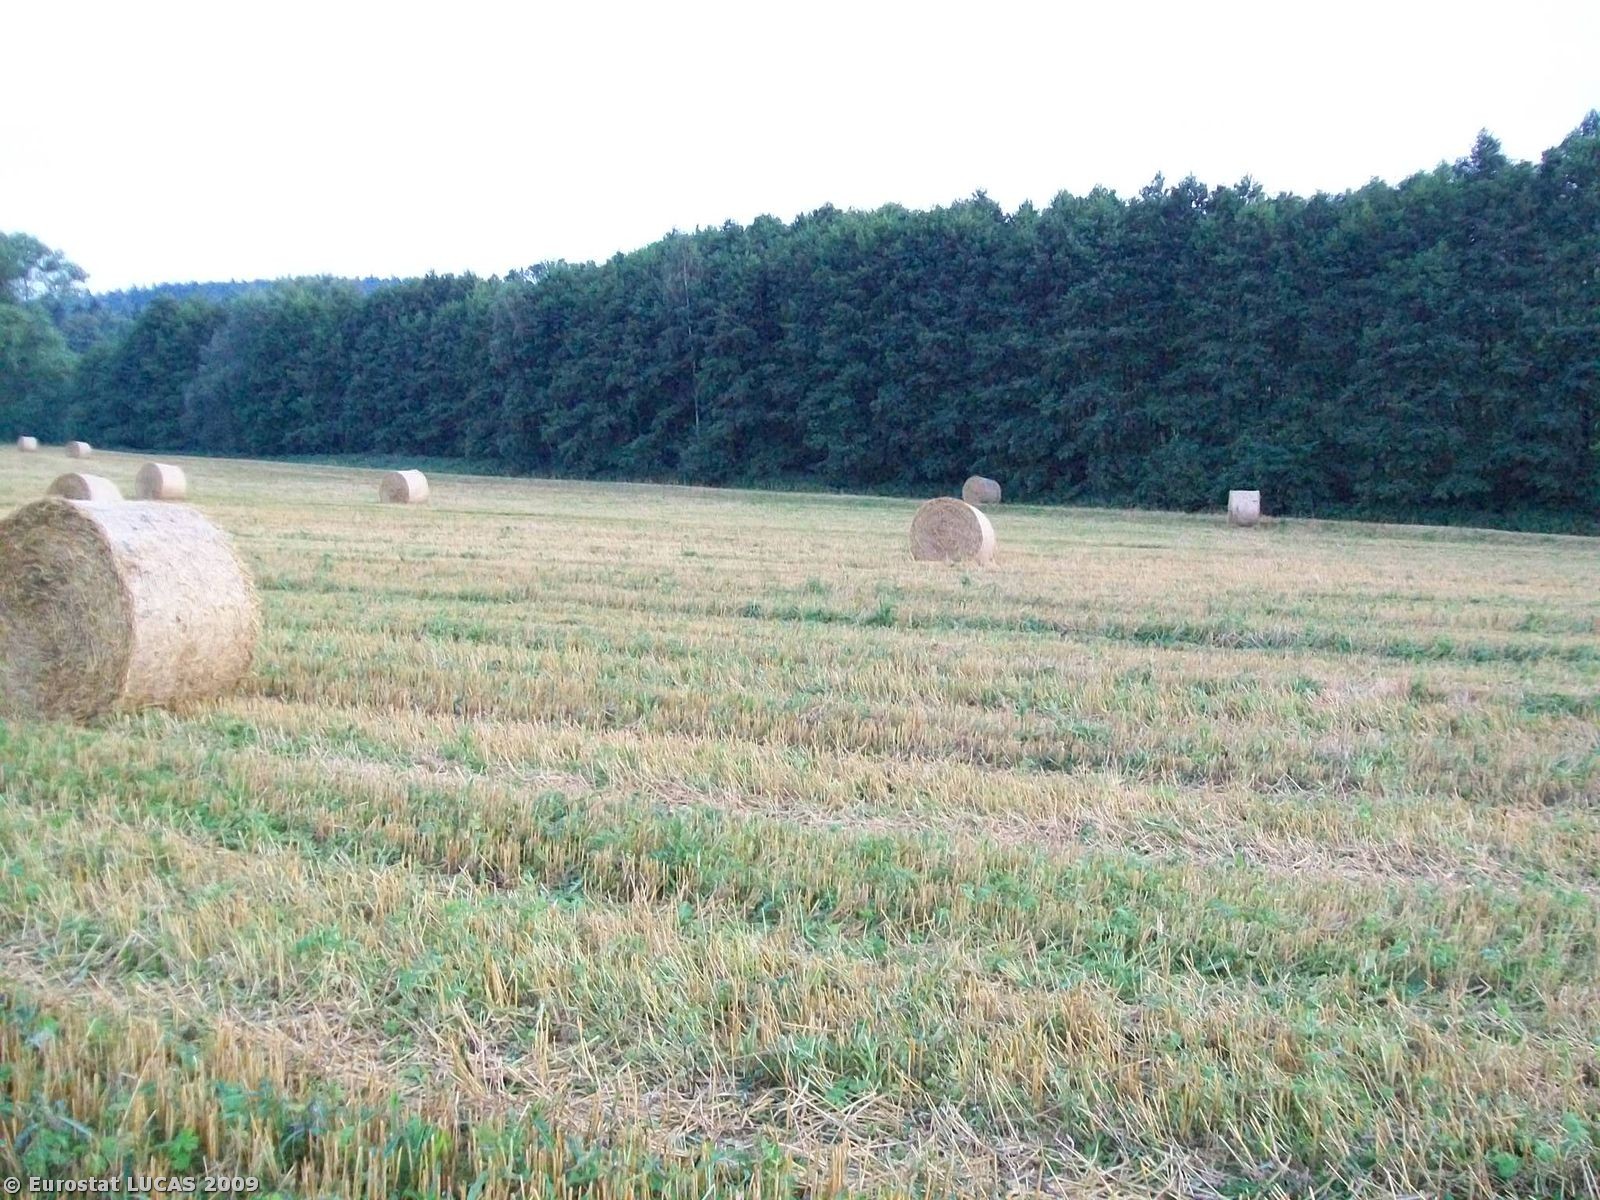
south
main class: Cropland
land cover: Common wheat
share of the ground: < 10 %
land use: Agriculture (excluding fallow land and kitchen gardens)
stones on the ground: < 10 %
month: September
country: PL
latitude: 50.6564
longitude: 16.6709
